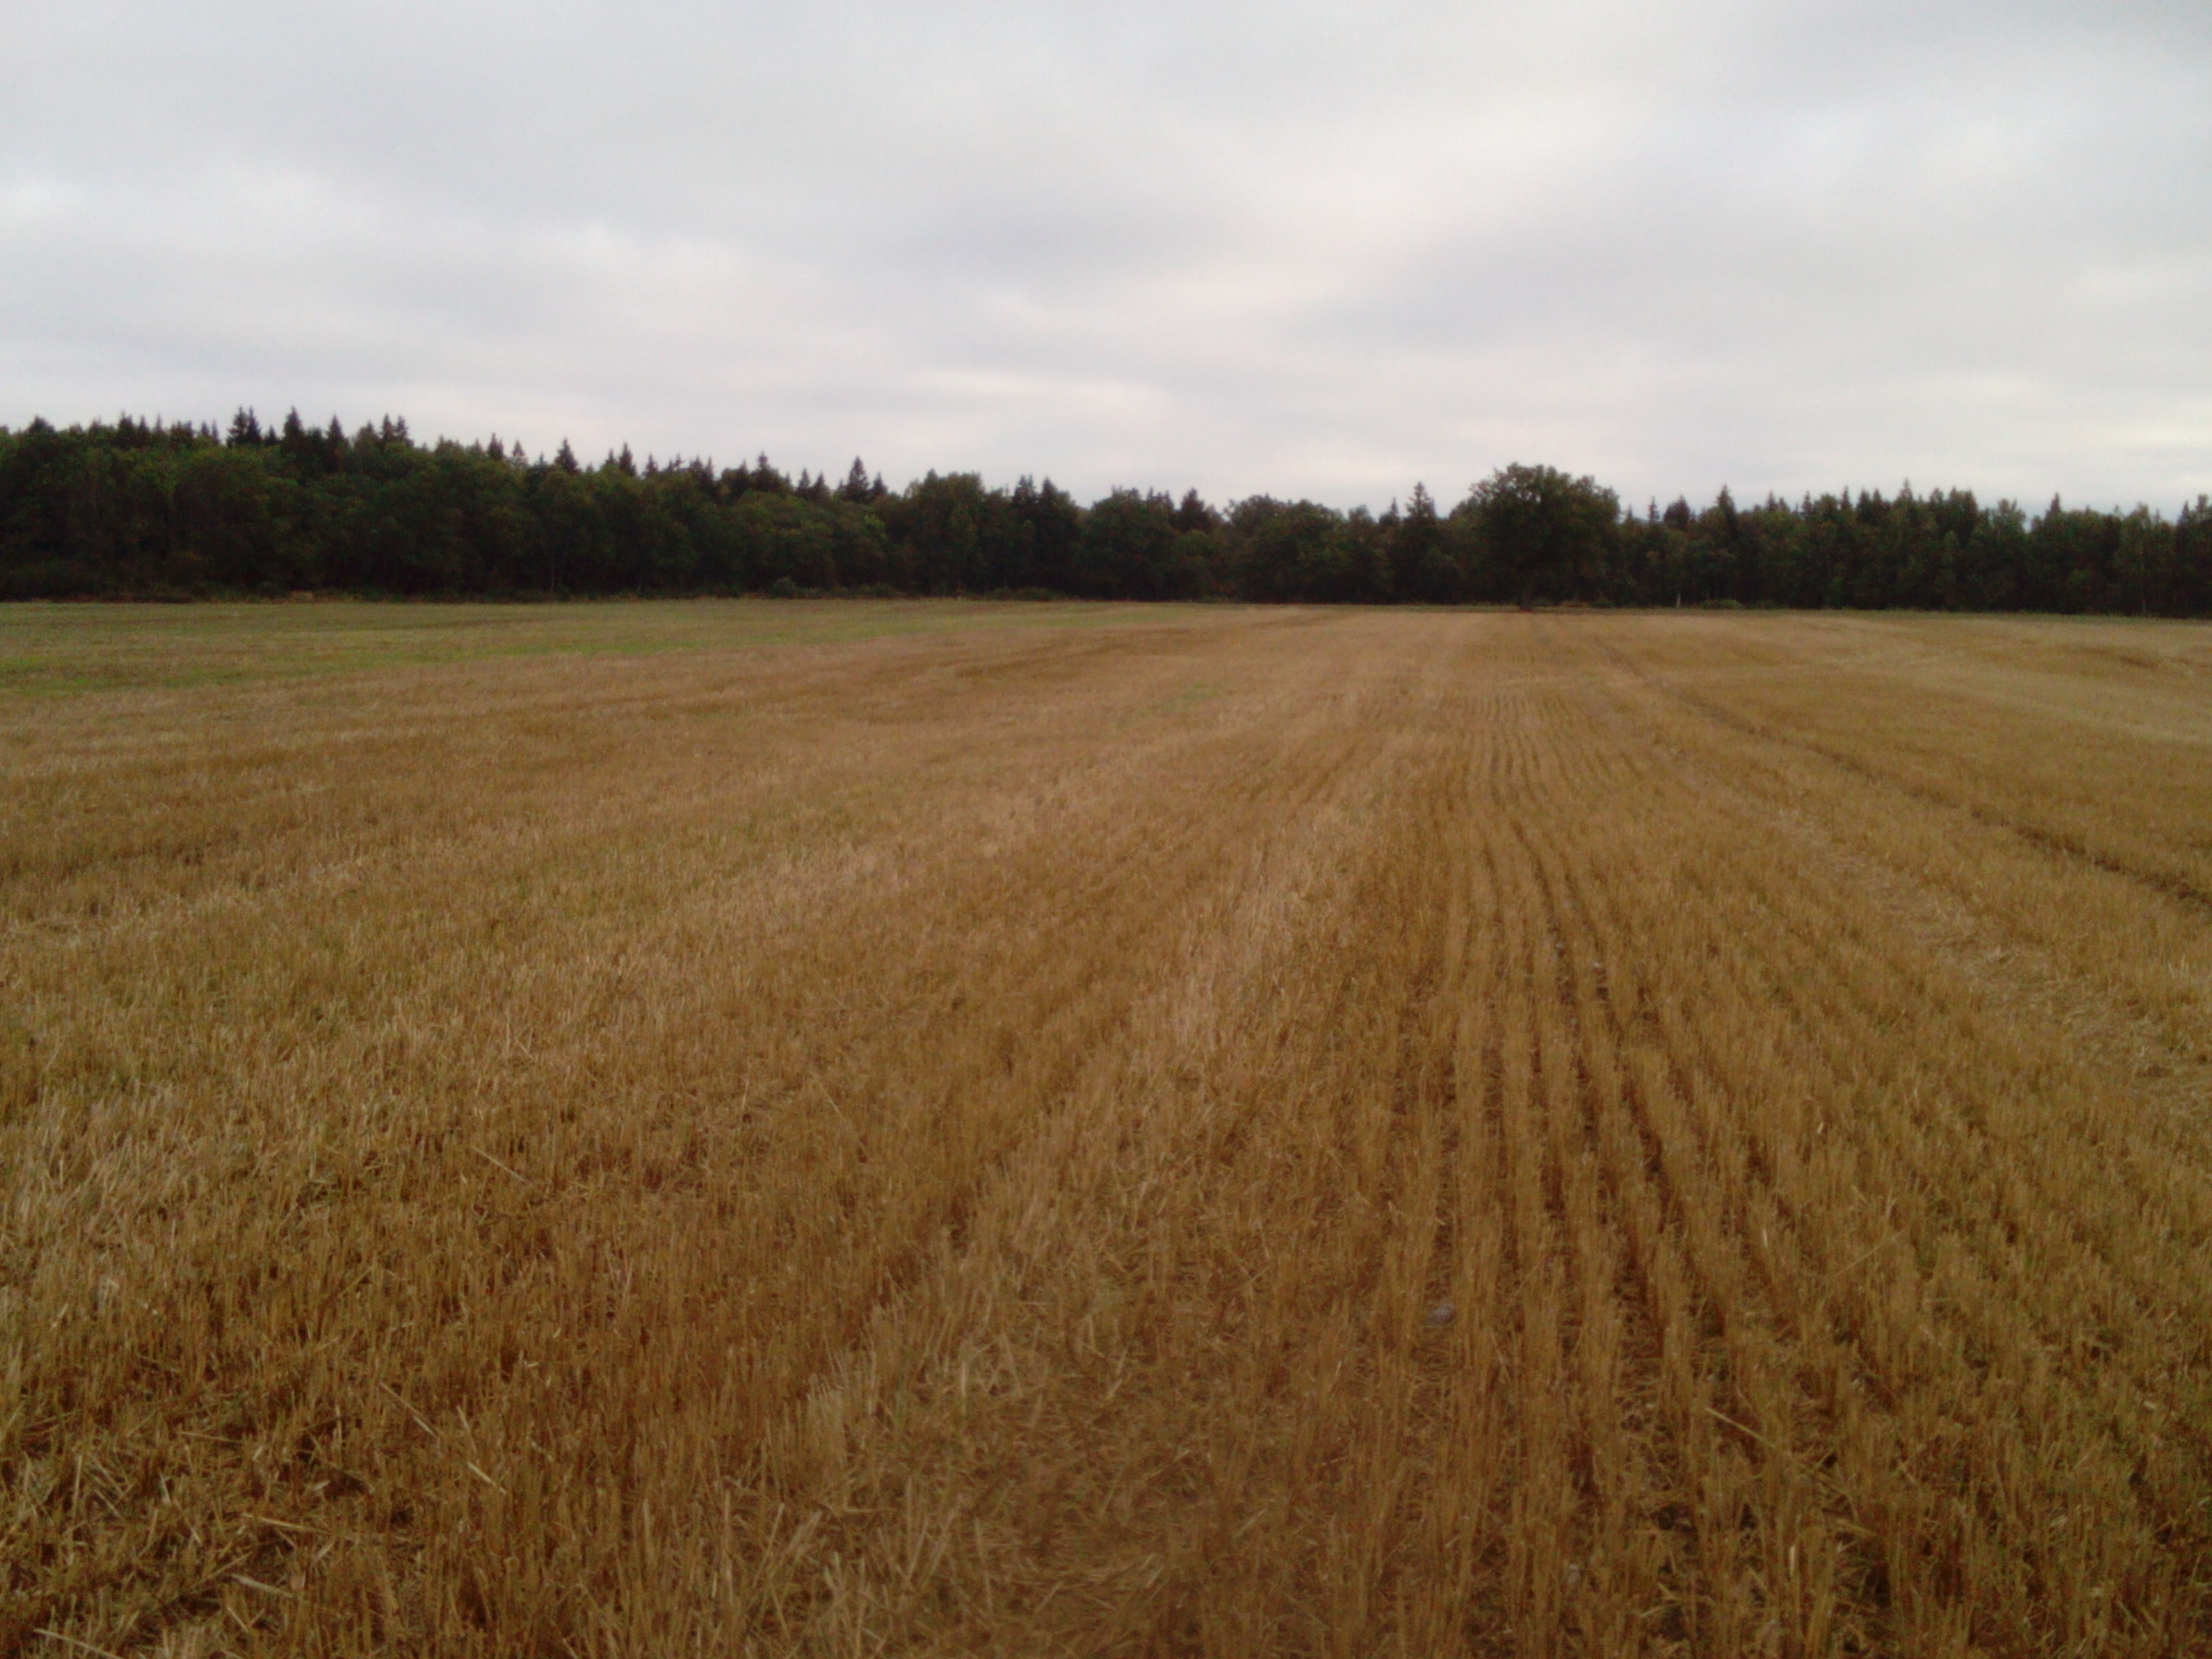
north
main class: Cropland
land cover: Barley
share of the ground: > 75 %
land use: Agriculture (excluding fallow land and kitchen gardens)
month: September
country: LT
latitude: 55.9354
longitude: 22.8885
